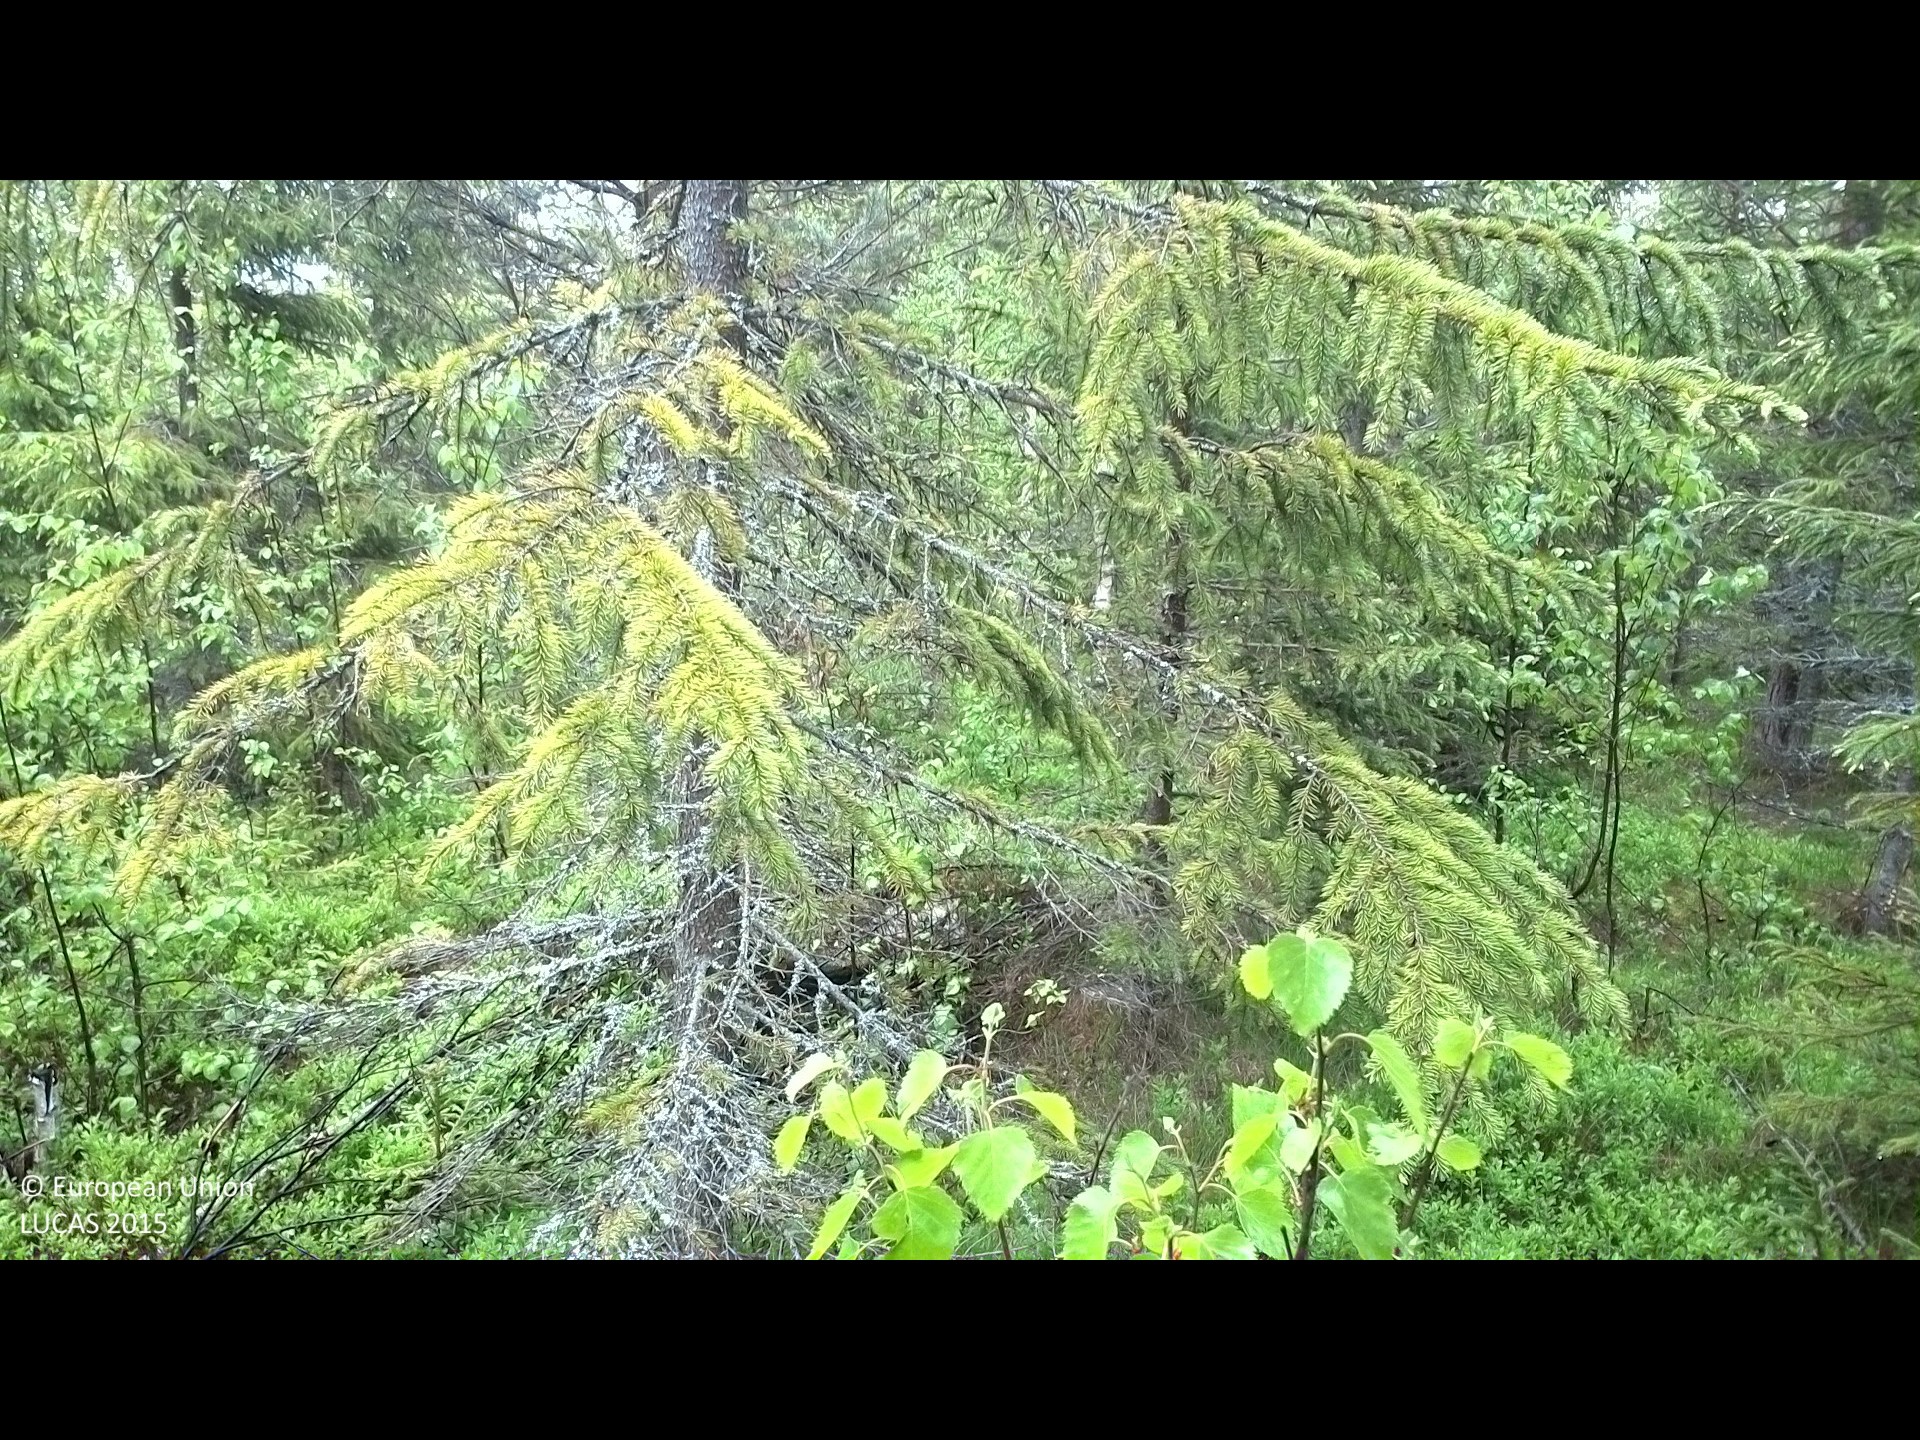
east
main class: Woodland
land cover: Spruce dominated mixed woodland
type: boreal forest
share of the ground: 25 - 50 %
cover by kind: shrubs 50 %, coniferous forest trees 25 %, broadleaved forest trees 15 %, lichens and mosses 10 %
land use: Forestry
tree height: > 5 m
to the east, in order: Spruce dominated mixed woodland; Pine dominated mixed woodland; Ditches and canals; Paved roads, cycling and walking lanes; Ditches and canals; Spruce dominated mixed woodland; Tracks; Pine dominated coniferous woodland; Tracks; Spruce dominated coniferous woodland
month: June
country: SE
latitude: 62.1532
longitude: 17.1395
